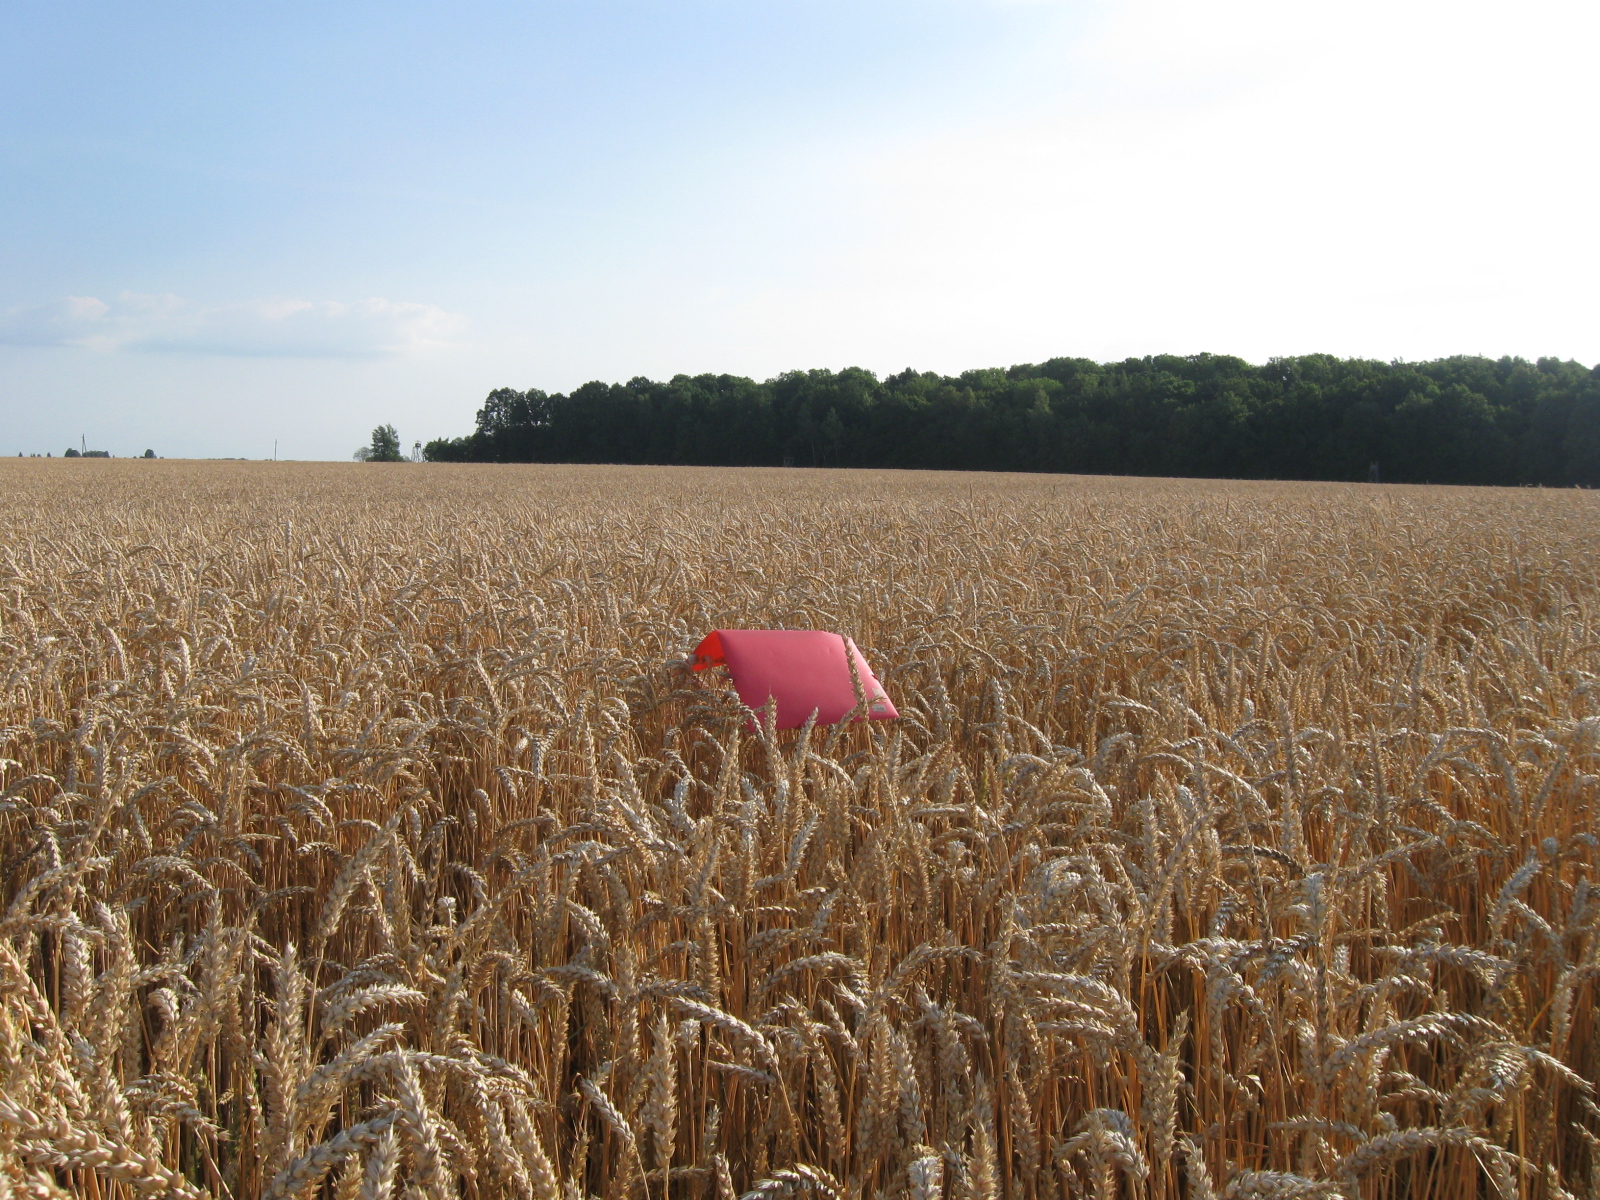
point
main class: Cropland
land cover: Common wheat
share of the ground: > 75 %
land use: Agriculture (excluding fallow land and kitchen gardens)
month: July
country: LT
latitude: 54.4561
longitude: 23.4230
